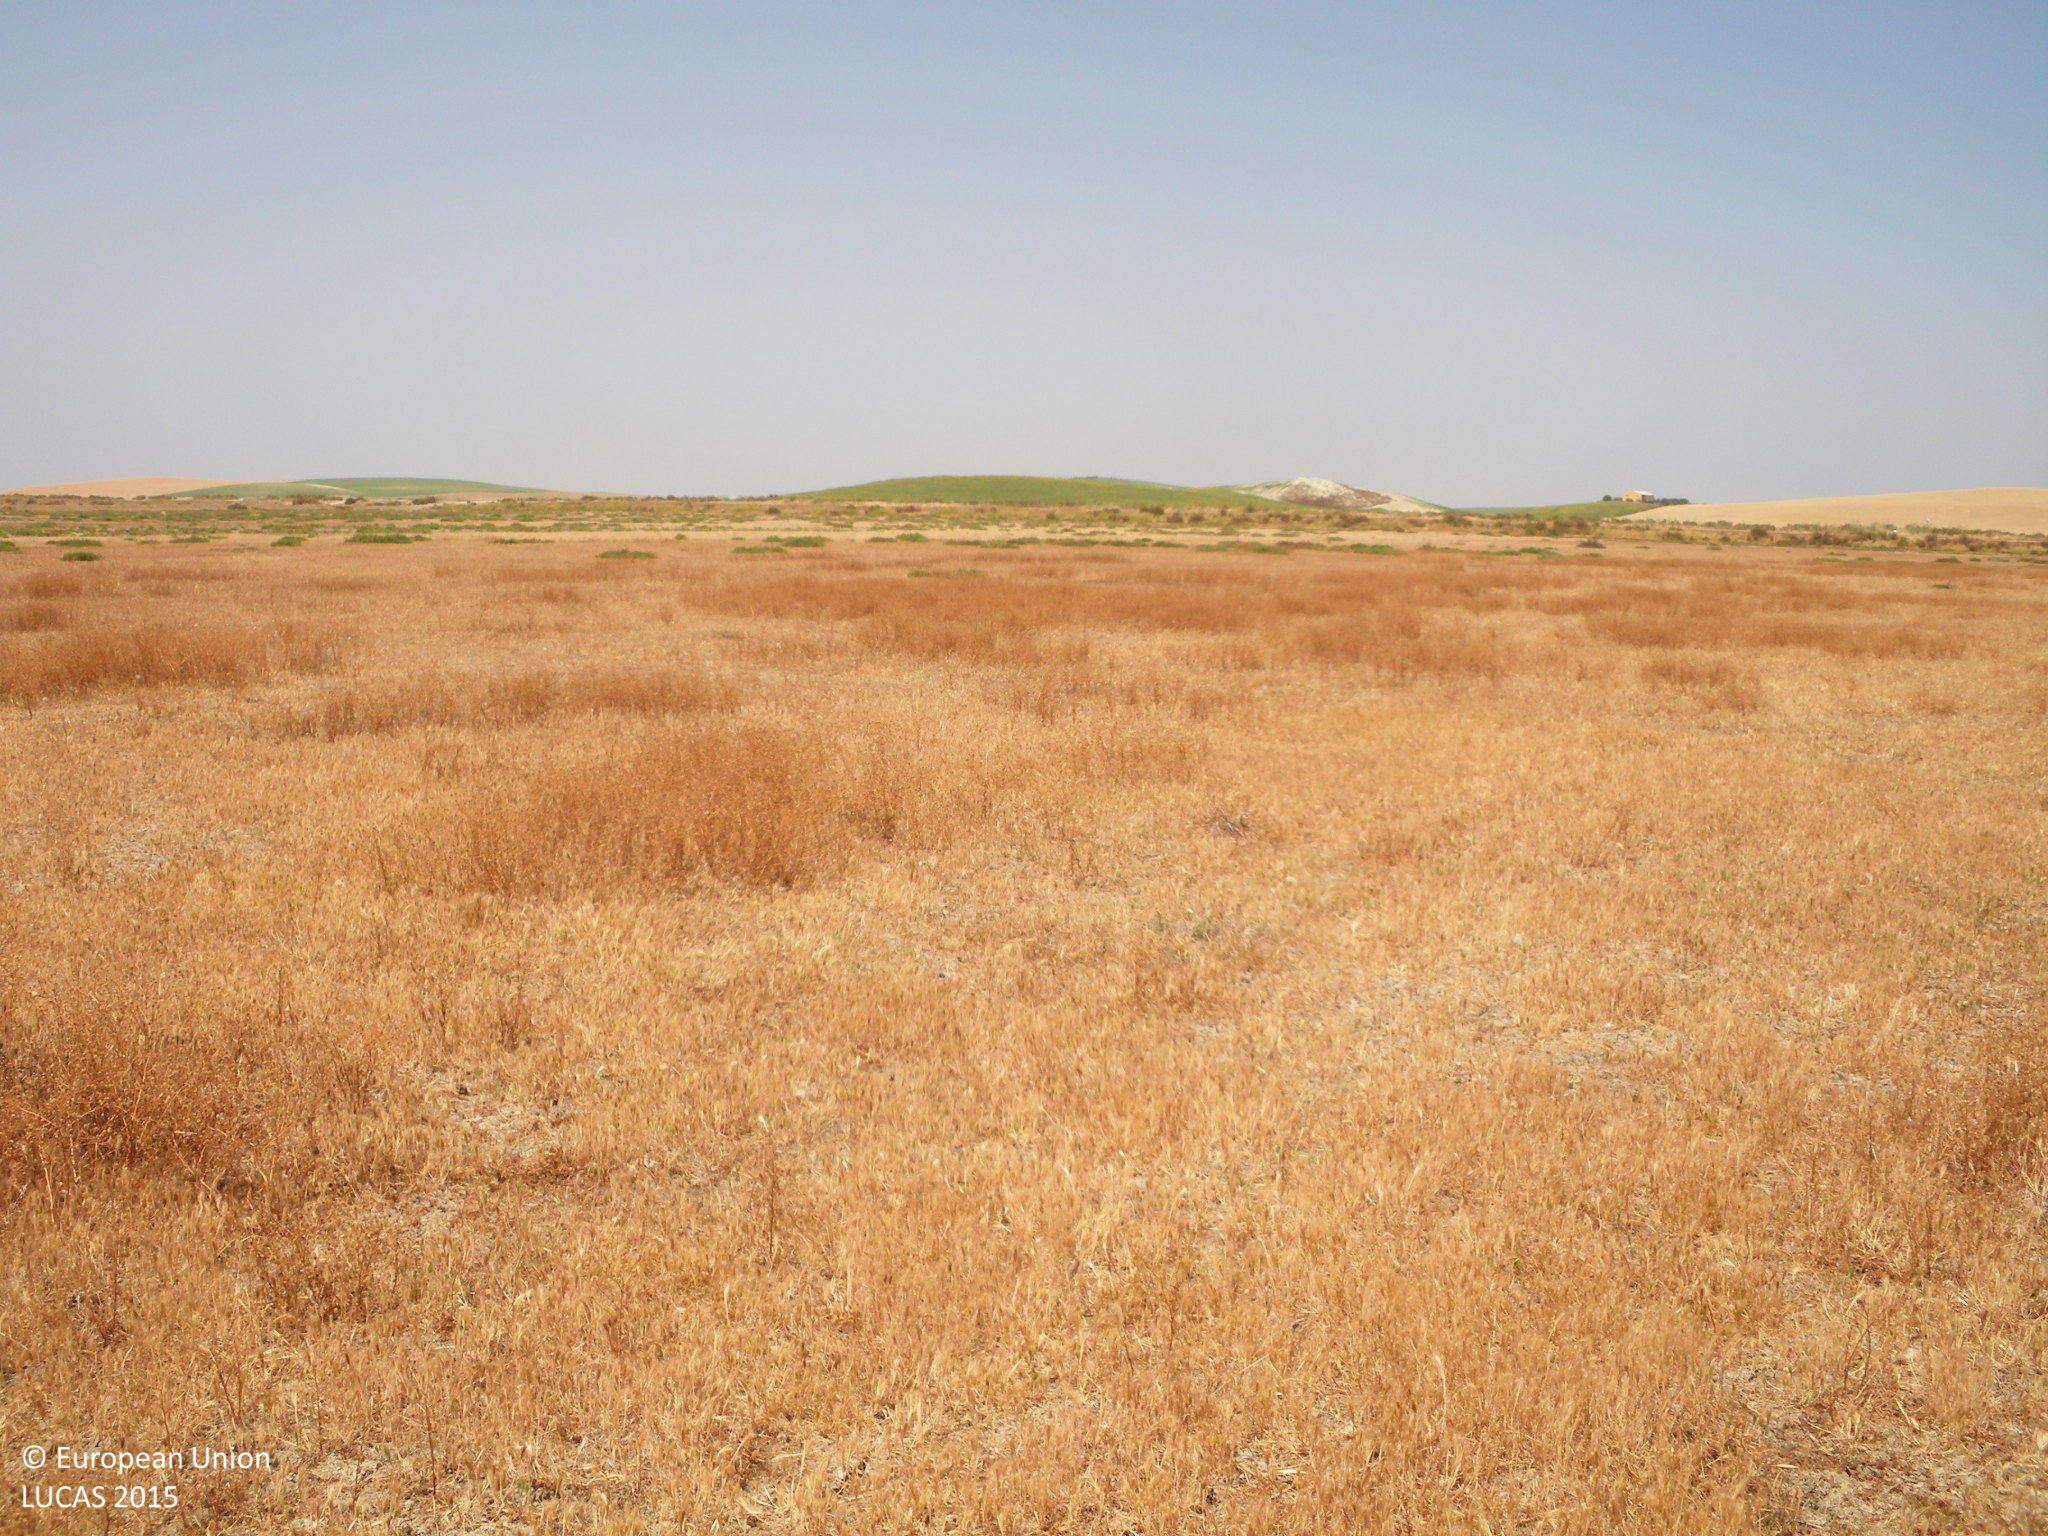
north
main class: Grassland
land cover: Spontaneously vegetated surfaces
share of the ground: > 75 %
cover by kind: herbaceous plants 90 %, unconsolidated bare surface 10 %
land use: Agriculture (excluding fallow land and kitchen gardens)
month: May
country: ES
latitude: 36.8430
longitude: -6.2210
